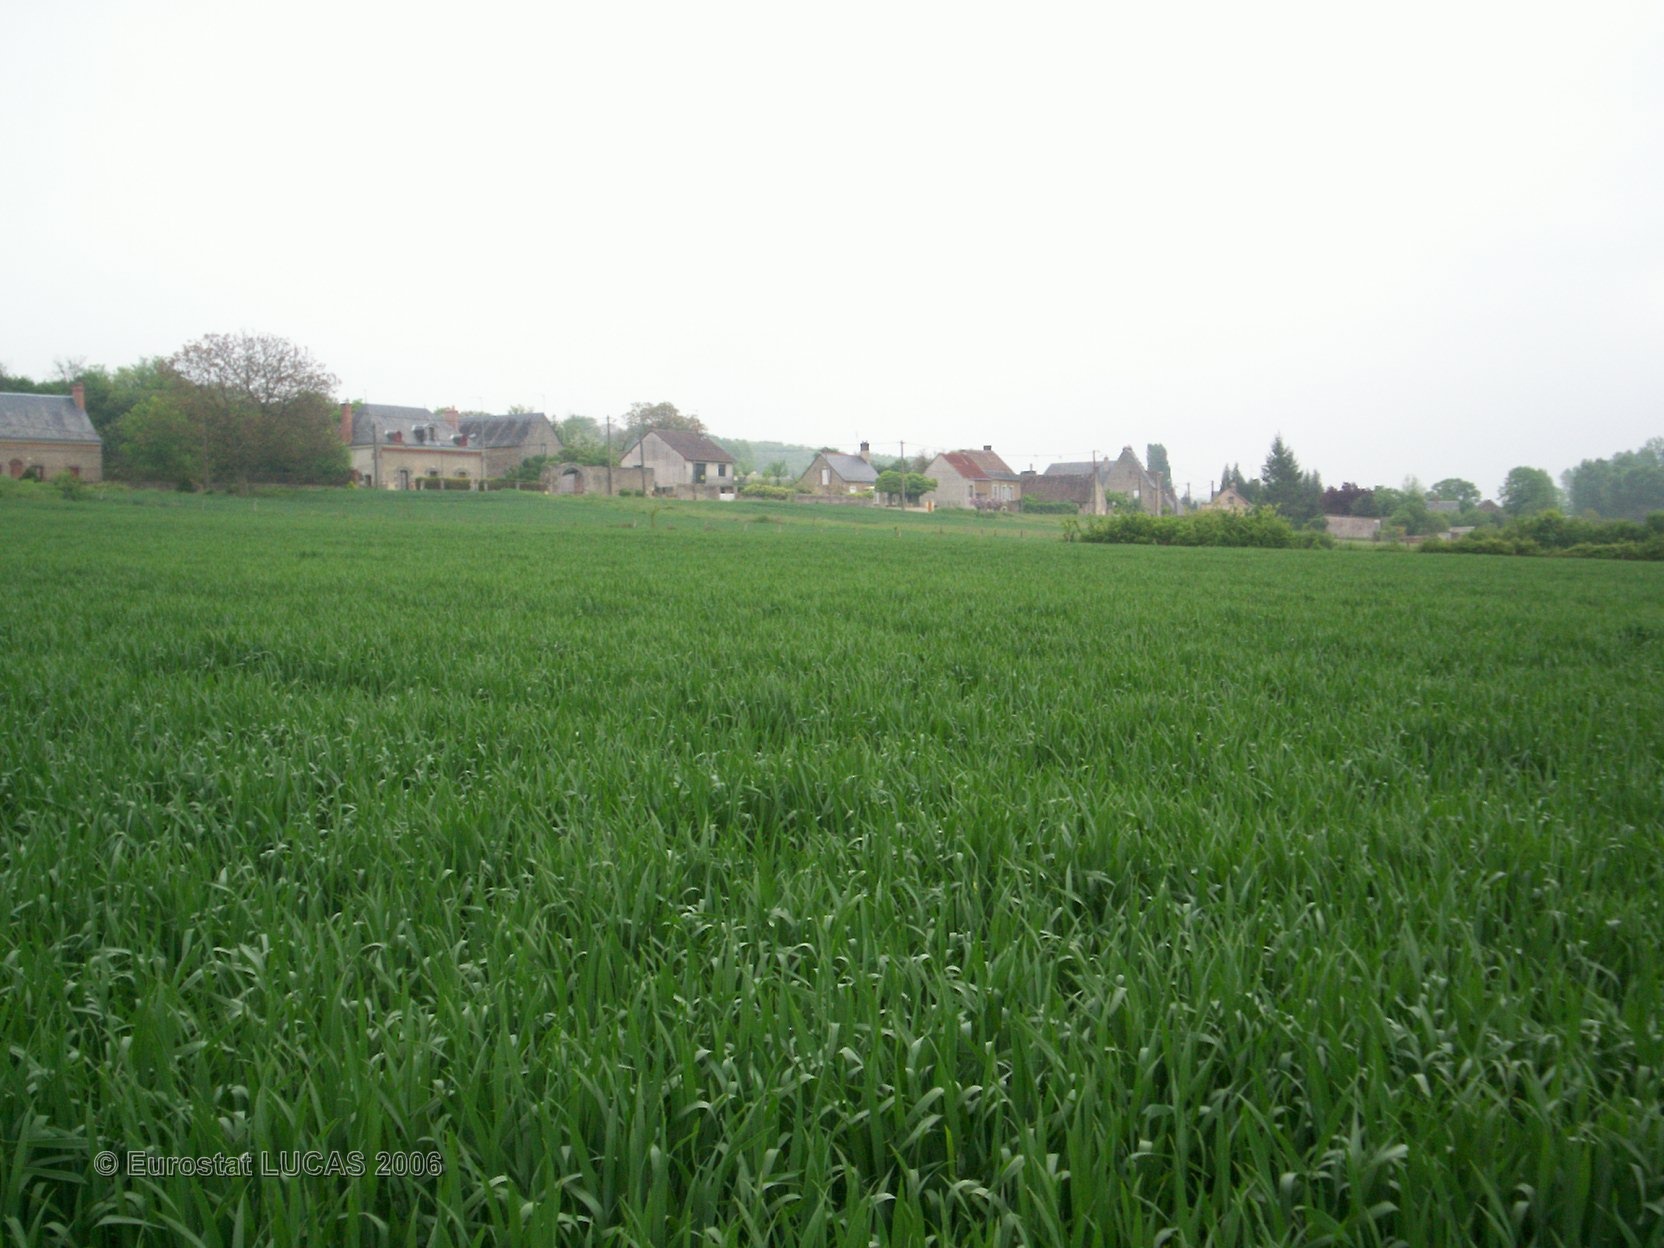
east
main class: Cropland
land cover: Common wheat
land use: Agriculture (excluding fallow land and kitchen gardens)
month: May
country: FR
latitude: 47.6660
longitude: 0.4827
